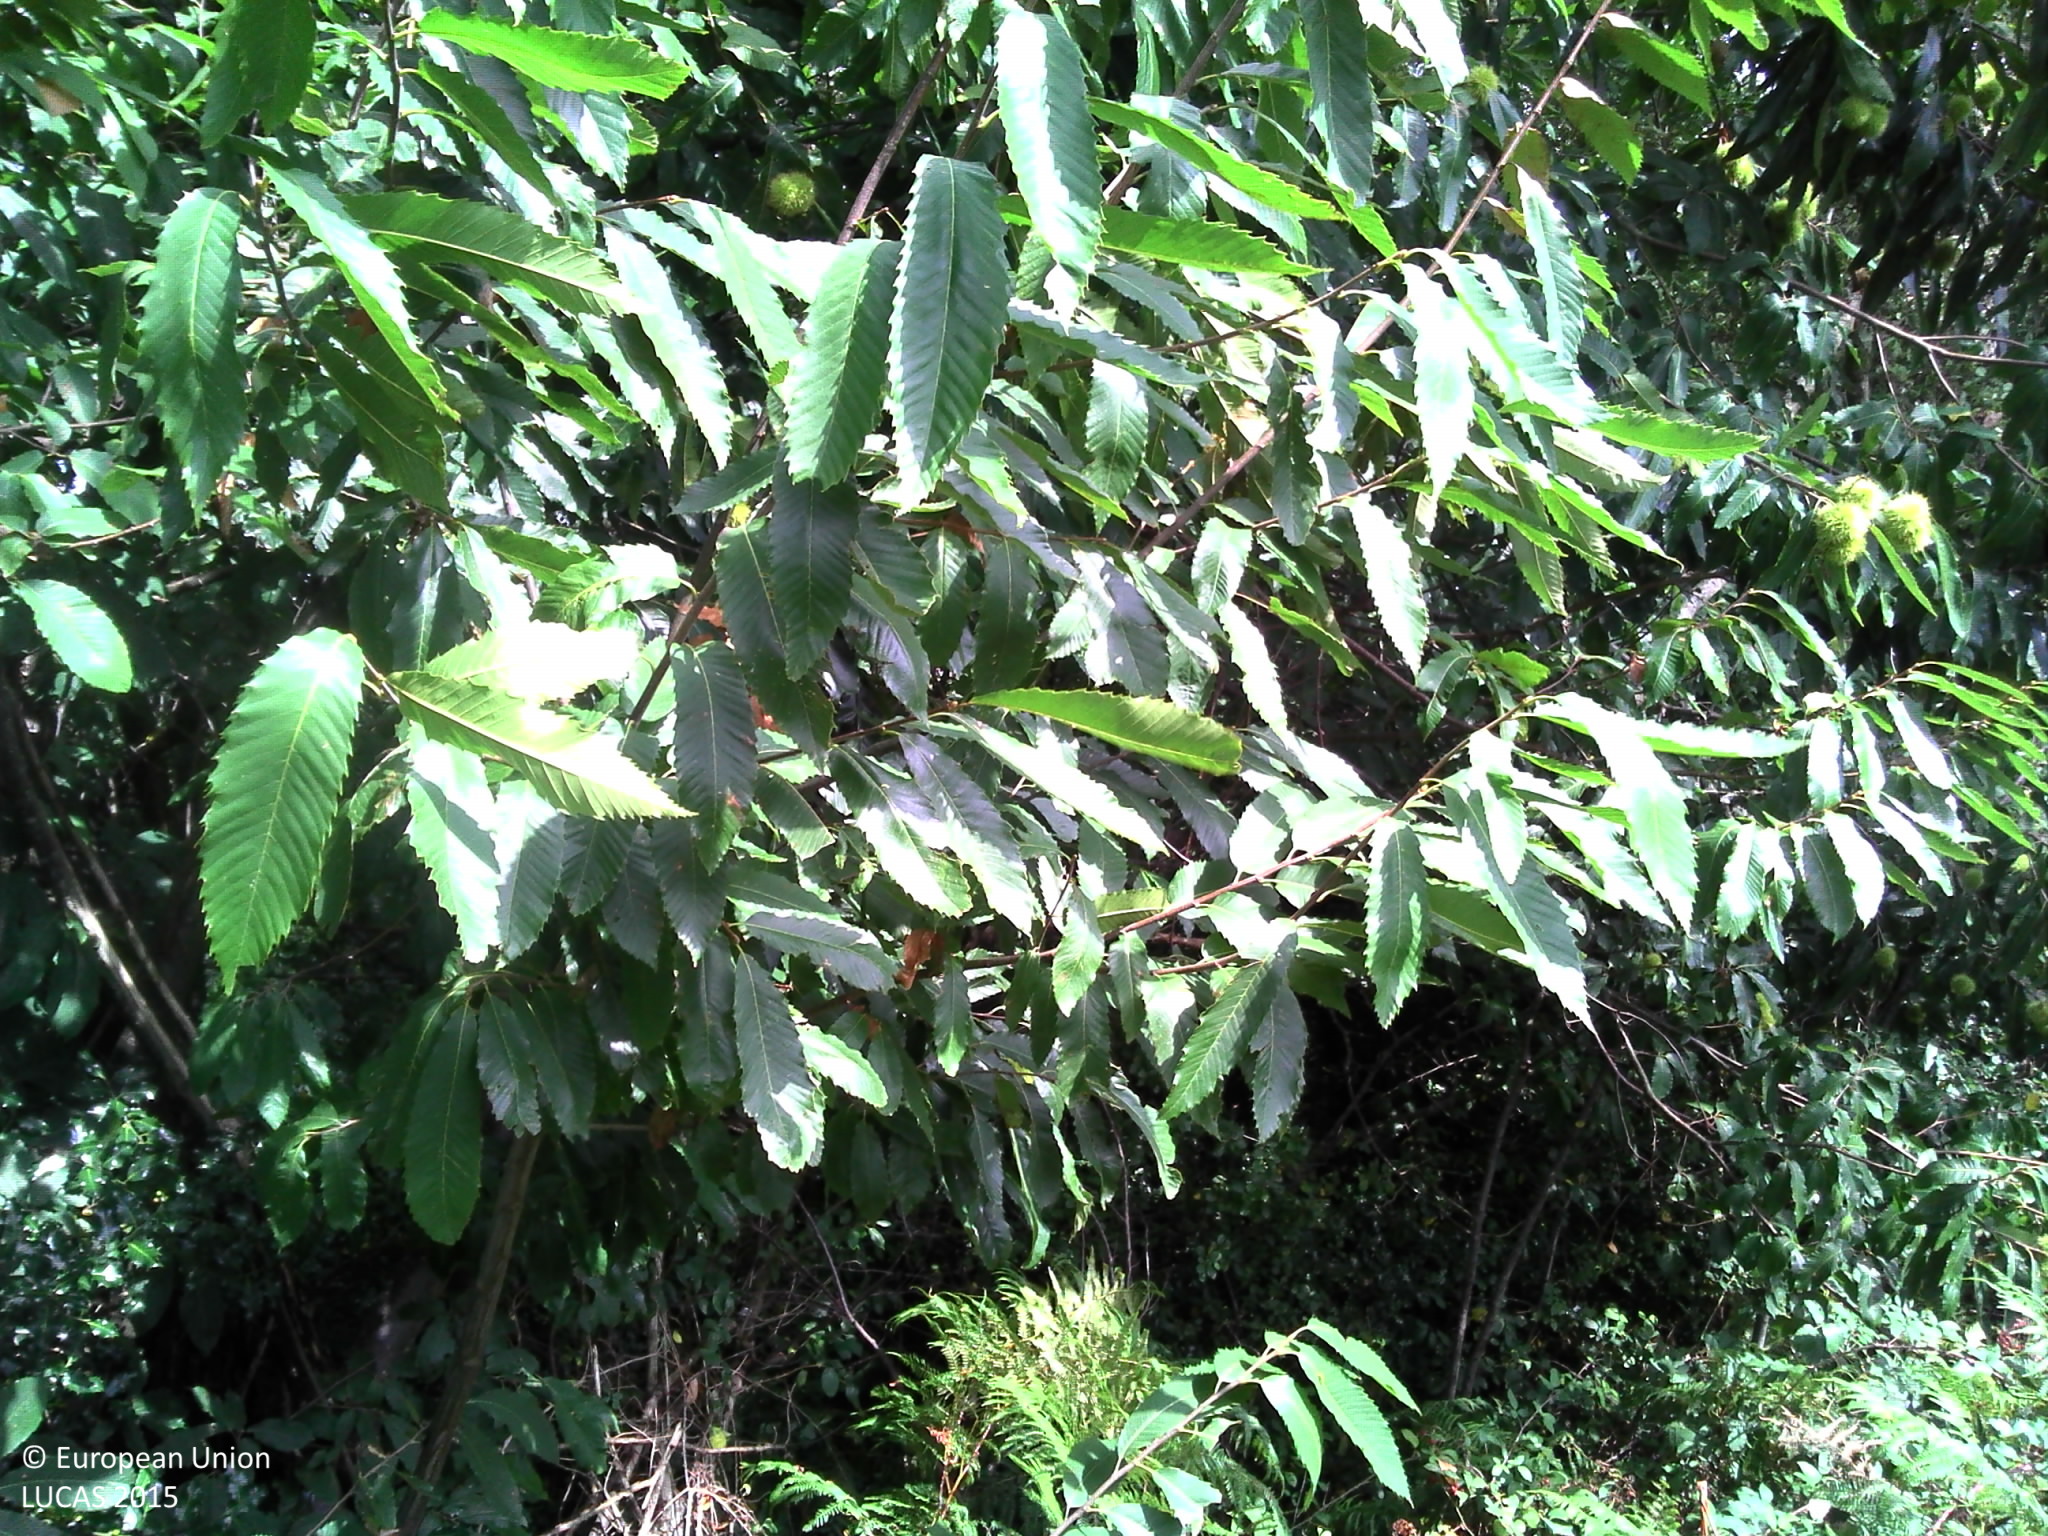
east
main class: Woodland
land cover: Broadleaved woodland
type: mesophytic deciduous forest
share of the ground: > 75 %
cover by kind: broadleaved forest trees 80 %, shrubs 10 %, herbaceous plants 5 %, lichens and mosses 5 %
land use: Forestry
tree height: > 5 m
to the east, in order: Grass margins; Broadleaved woodland; Fences; Grassland without tree/shrub cover; Fences; Managed hedges; Ditches and canals; Tracks; Broadleaved woodland; Rivers and streams; Broadleaved woodland
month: September
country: FR
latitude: 43.4493
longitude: -0.1762
